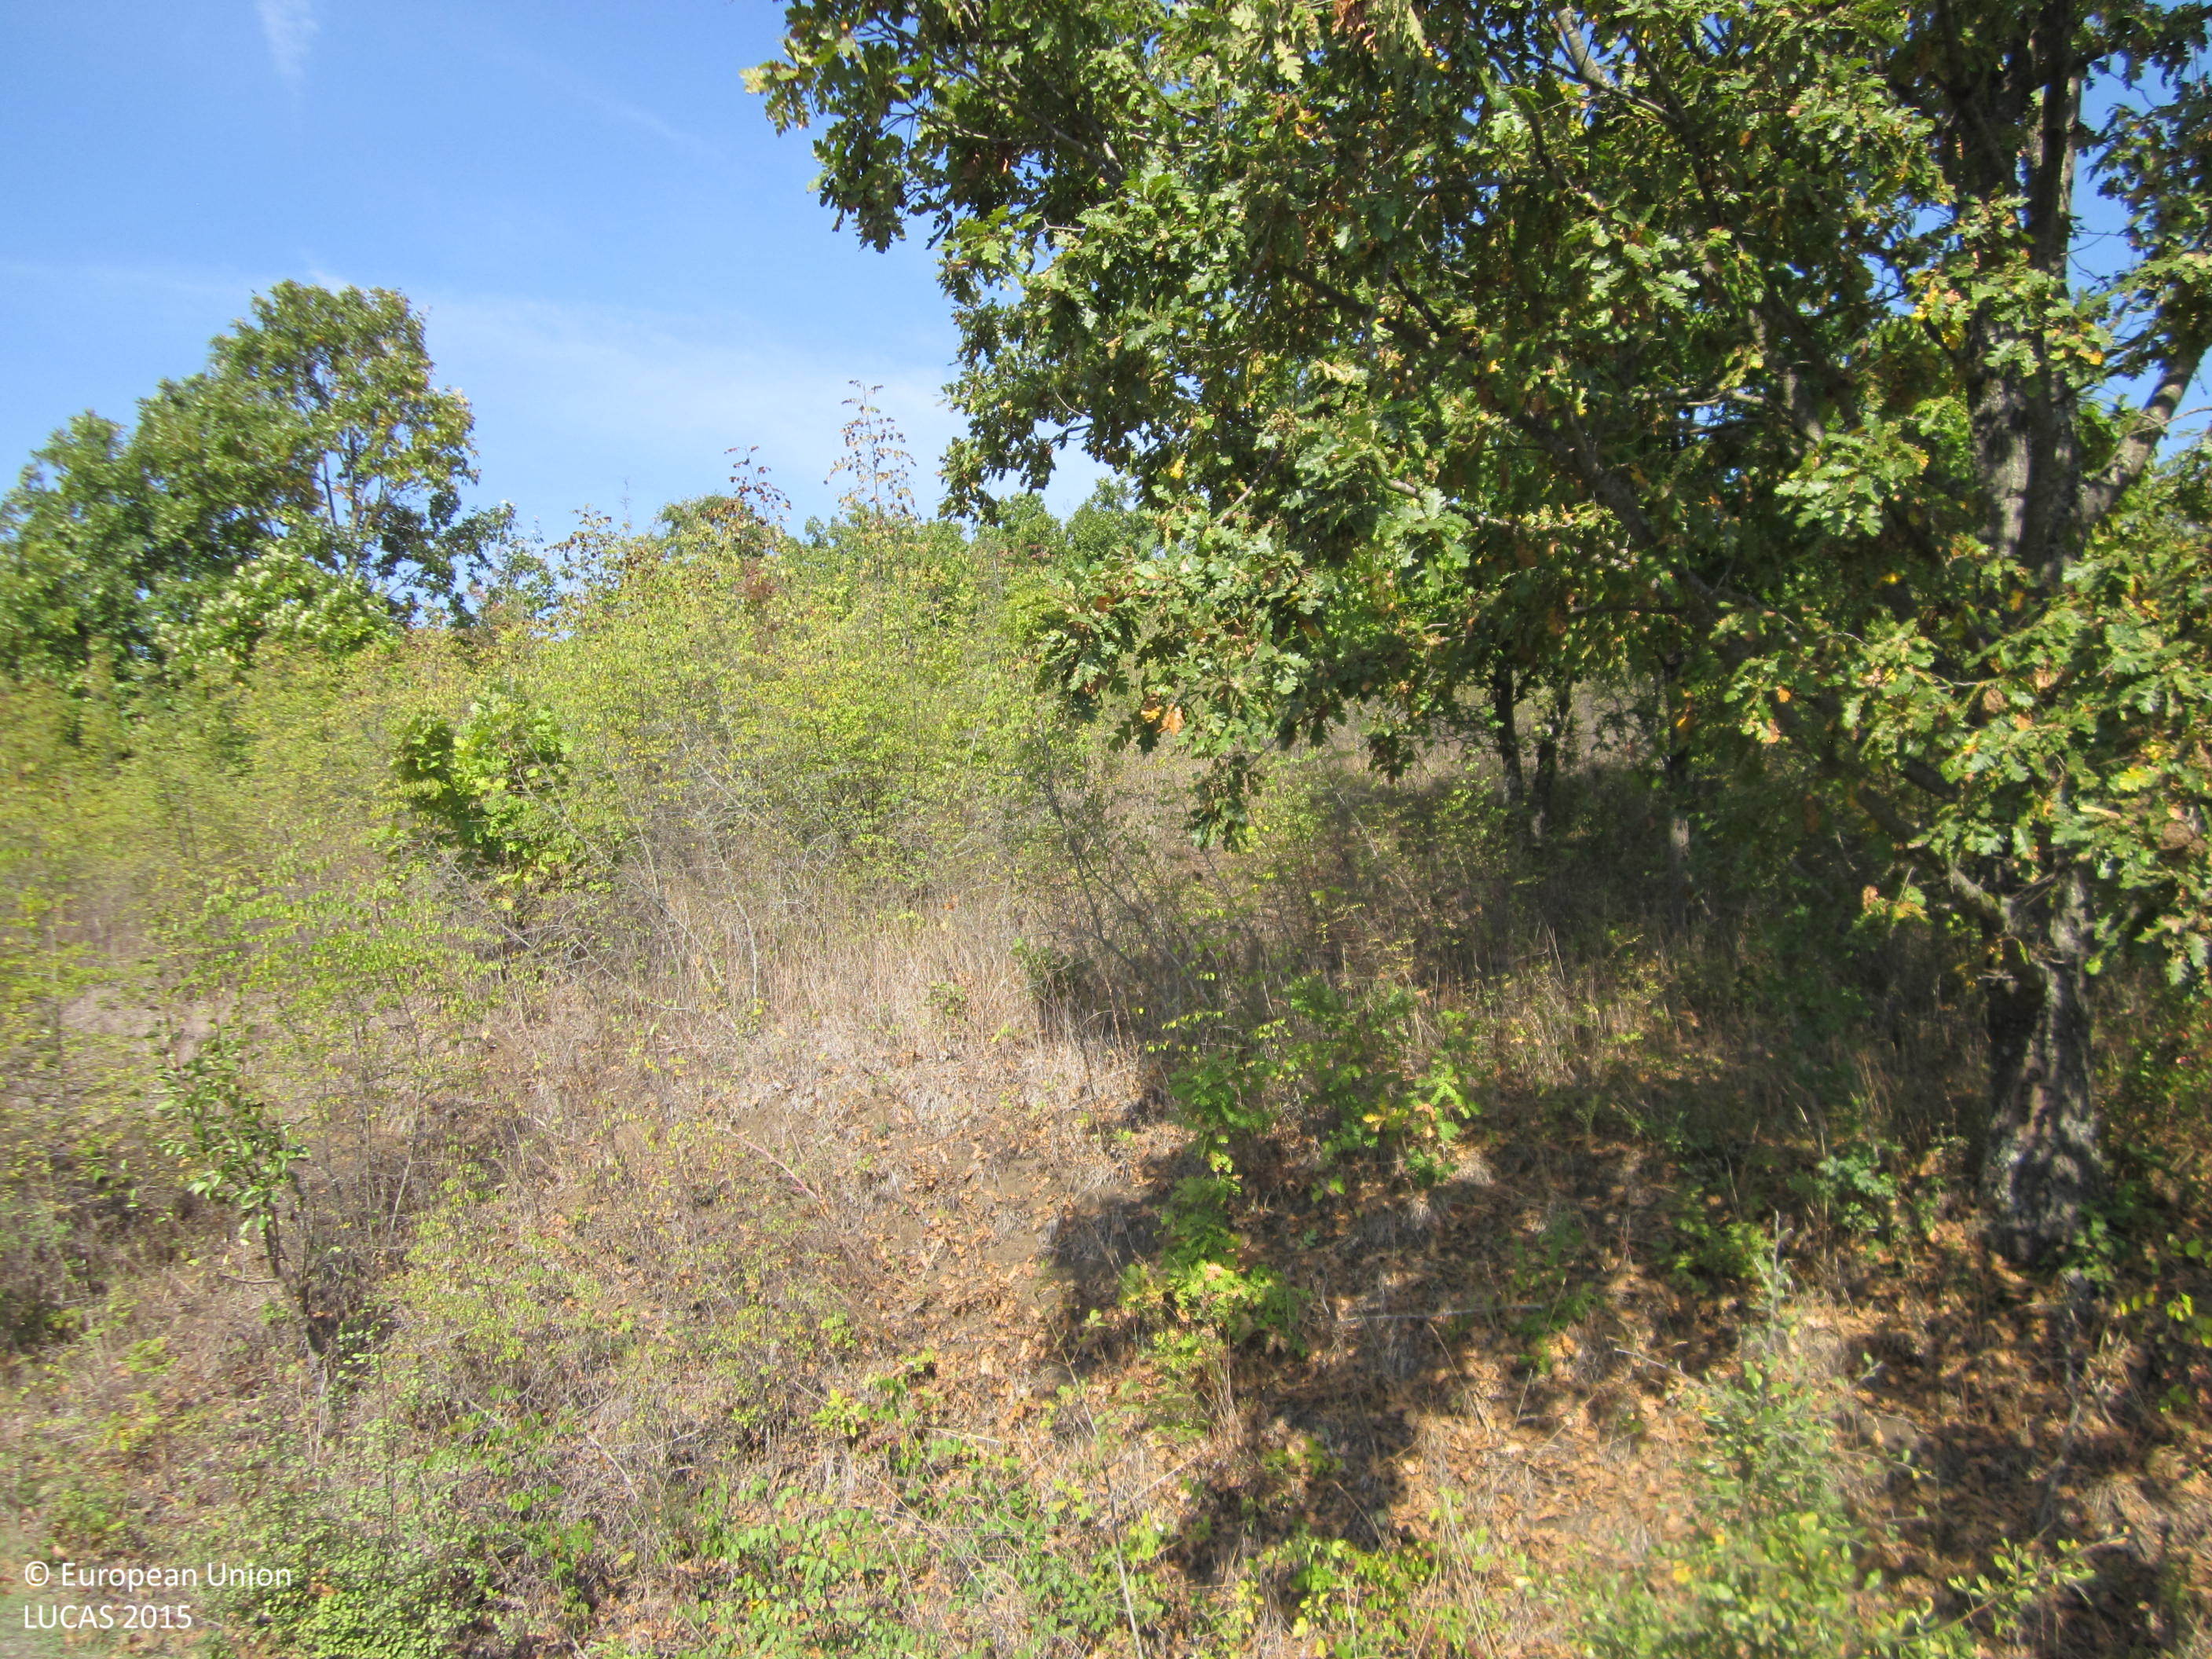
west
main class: Shrubland
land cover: Shrubland with sparse tree cover
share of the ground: > 75 %
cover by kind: shrubs 85 %, broadleaved forest trees 5 %, herbaceous plants 5 %, consolidated bare surface 5 %
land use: Semi-natural and natural areas not in use
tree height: < 5 m
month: September
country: BG
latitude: 42.1983
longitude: 27.7409
